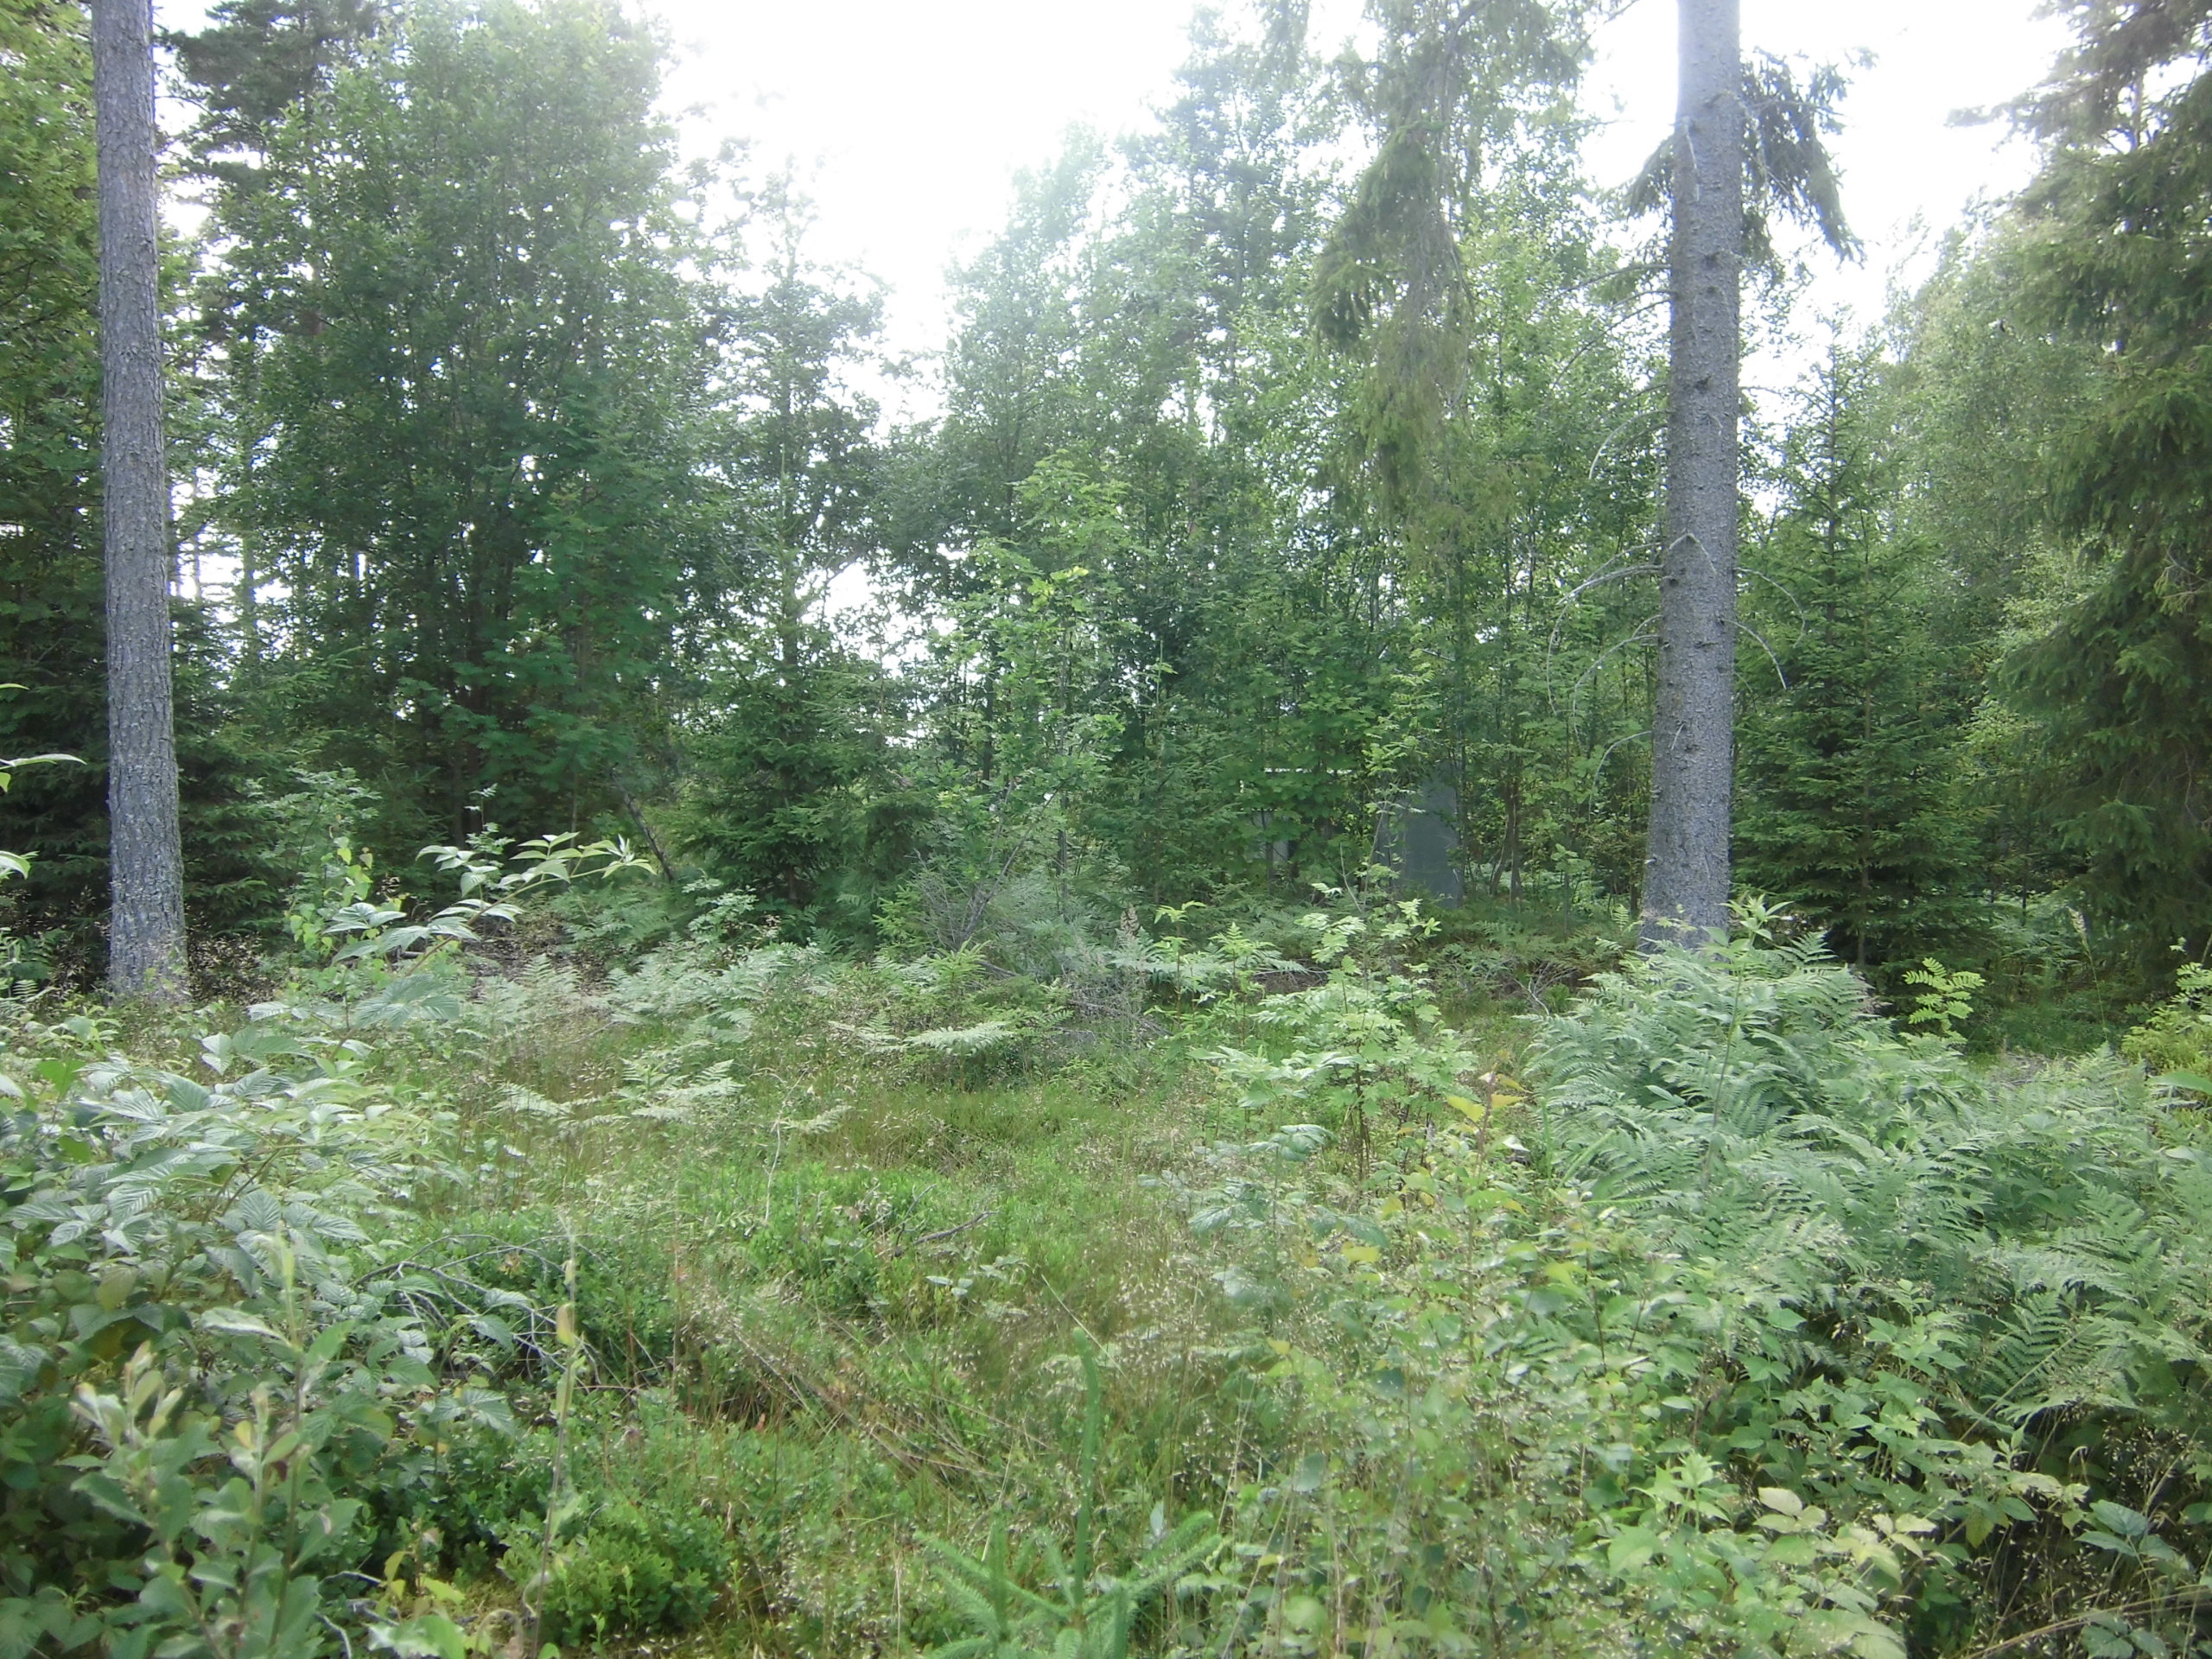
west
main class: Woodland
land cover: Spruce dominated mixed woodland
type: boreal forest
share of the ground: 10 - 25 %
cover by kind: herbaceous plants 45 %, shrubs 35 %, broadleaved forest trees 10 %, coniferous forest trees 5 %, lichens and mosses 5 %
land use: Forestry
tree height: < 5 m
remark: Clear cut
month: July
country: SE
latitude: 57.4336
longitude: 15.2101
